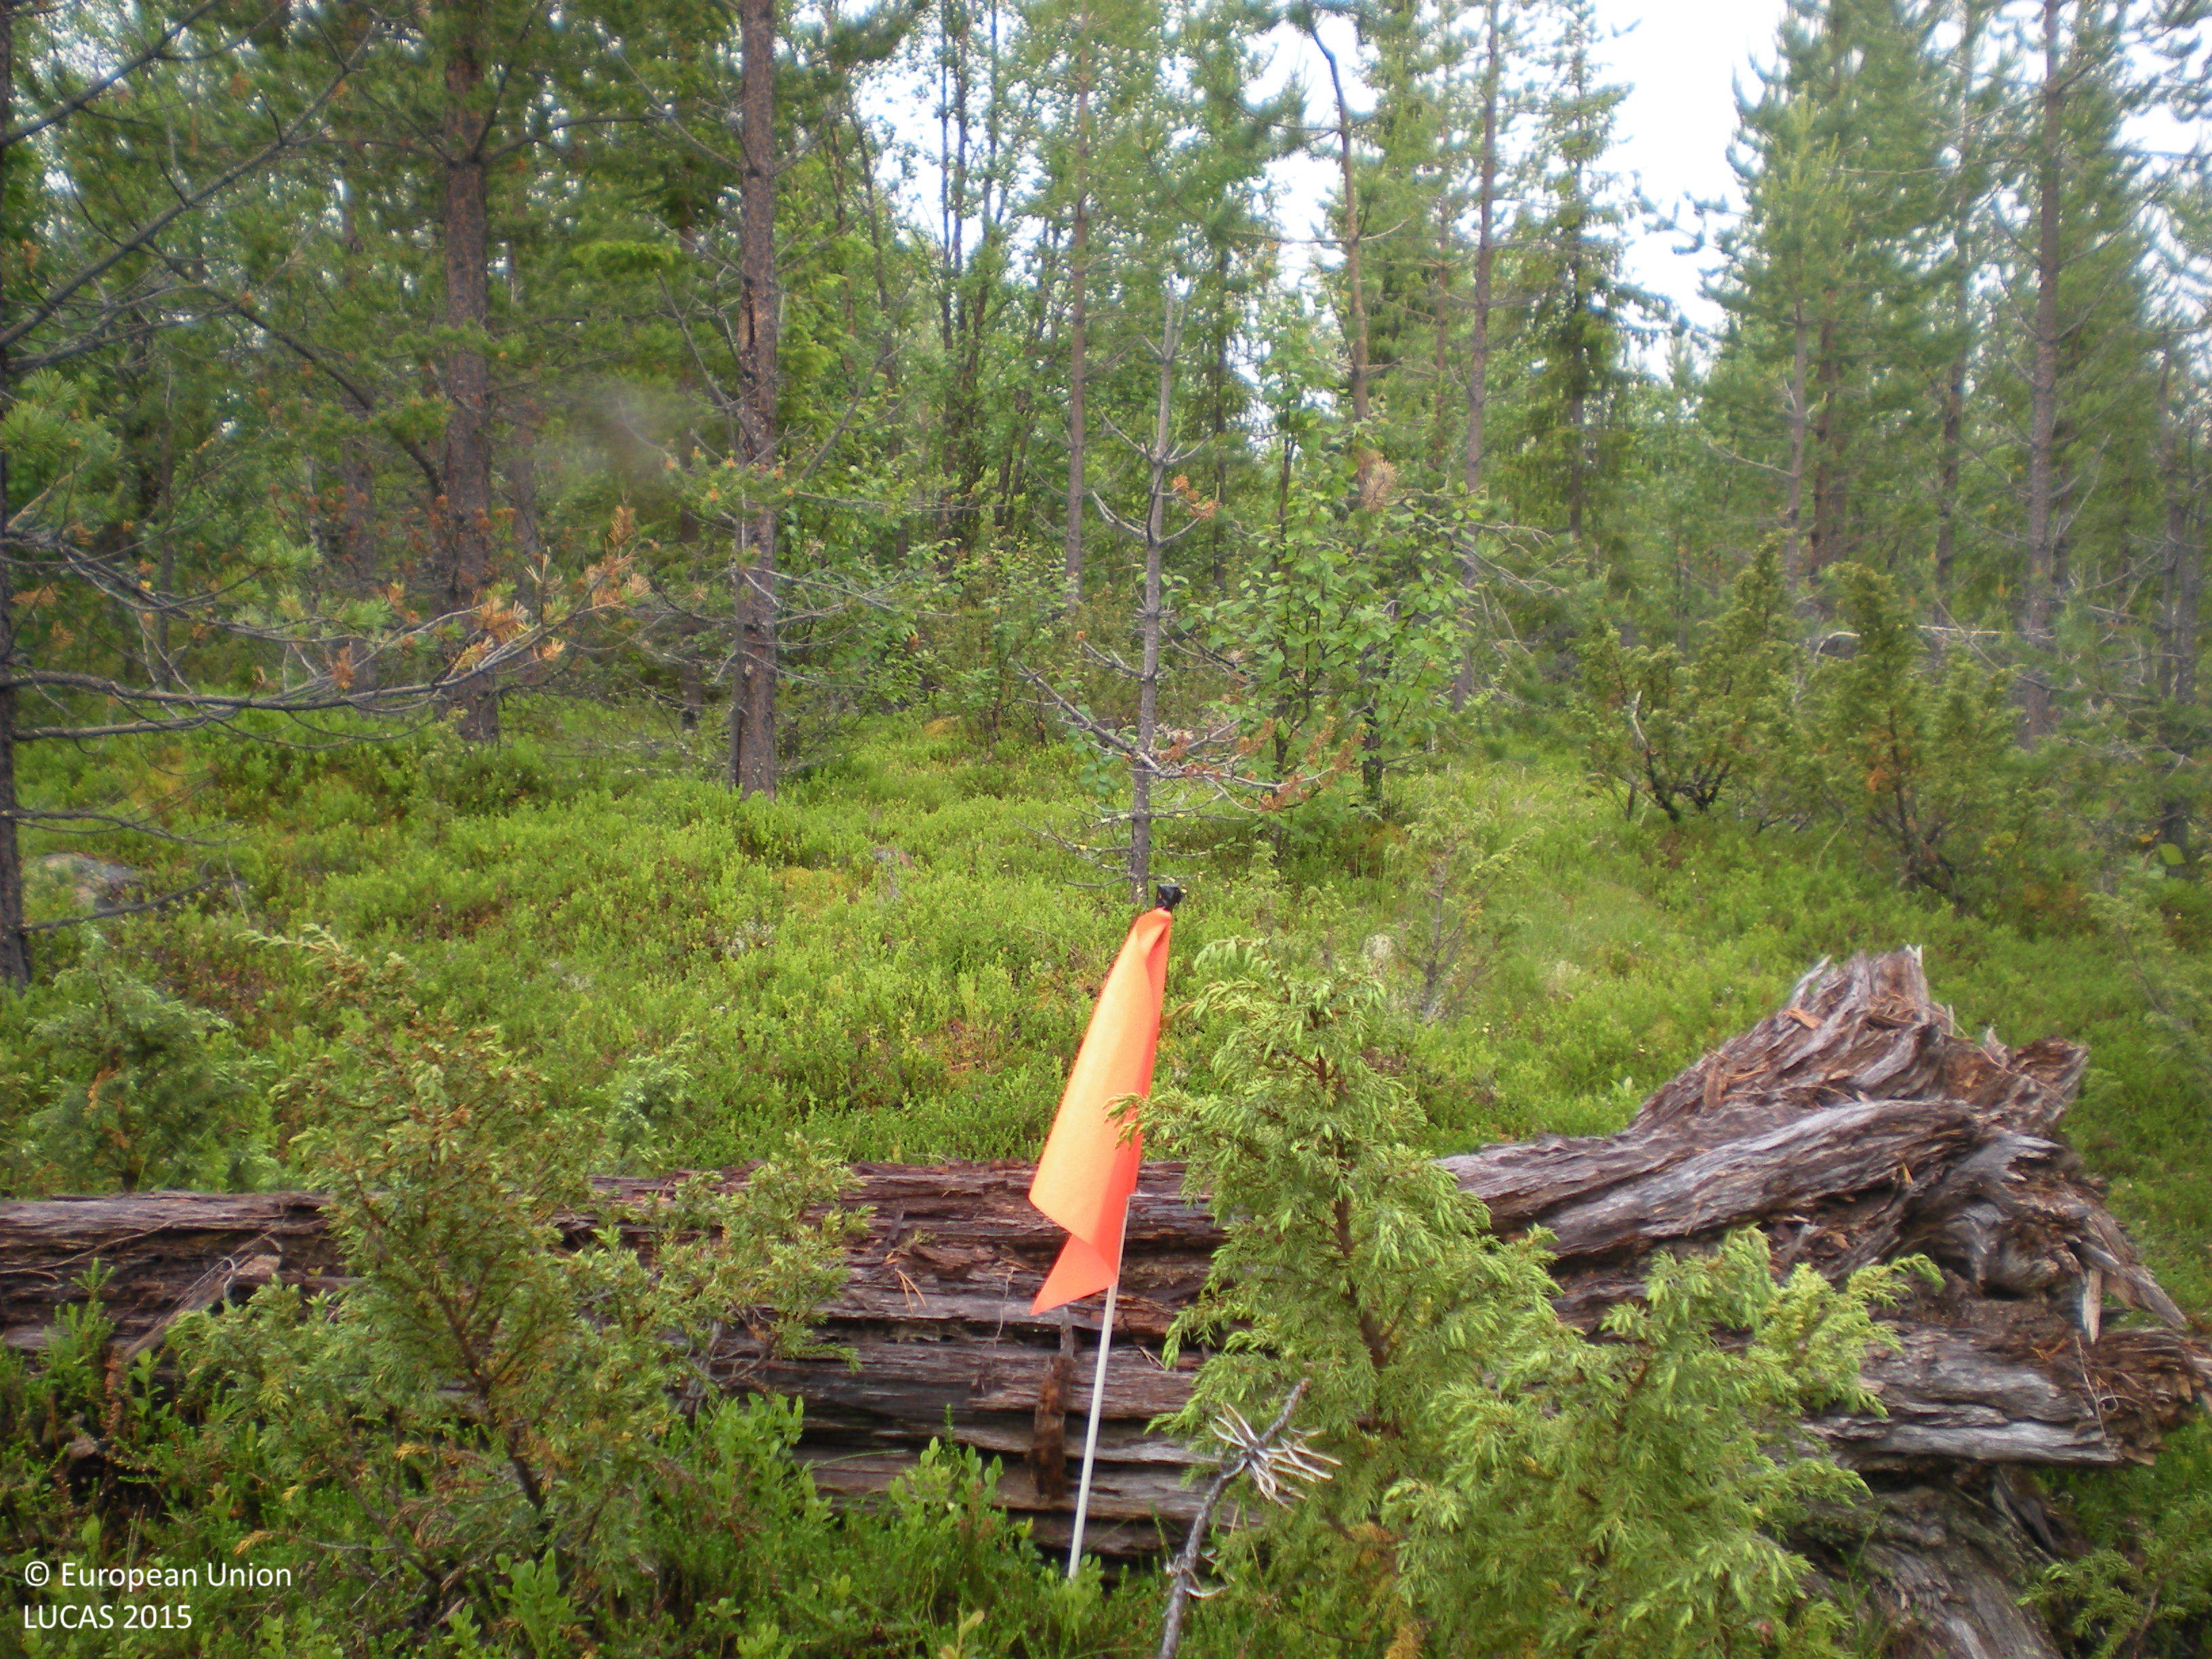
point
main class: Woodland
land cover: Pine dominated mixed woodland
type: boreal forest
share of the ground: 50 - 75 %
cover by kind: coniferous forest trees 45 %, shrubs 30 %, broadleaved forest trees 15 %, lichens and mosses 10 %
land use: Forestry
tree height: > 5 m
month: July
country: SE
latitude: 65.7566
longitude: 17.2697
